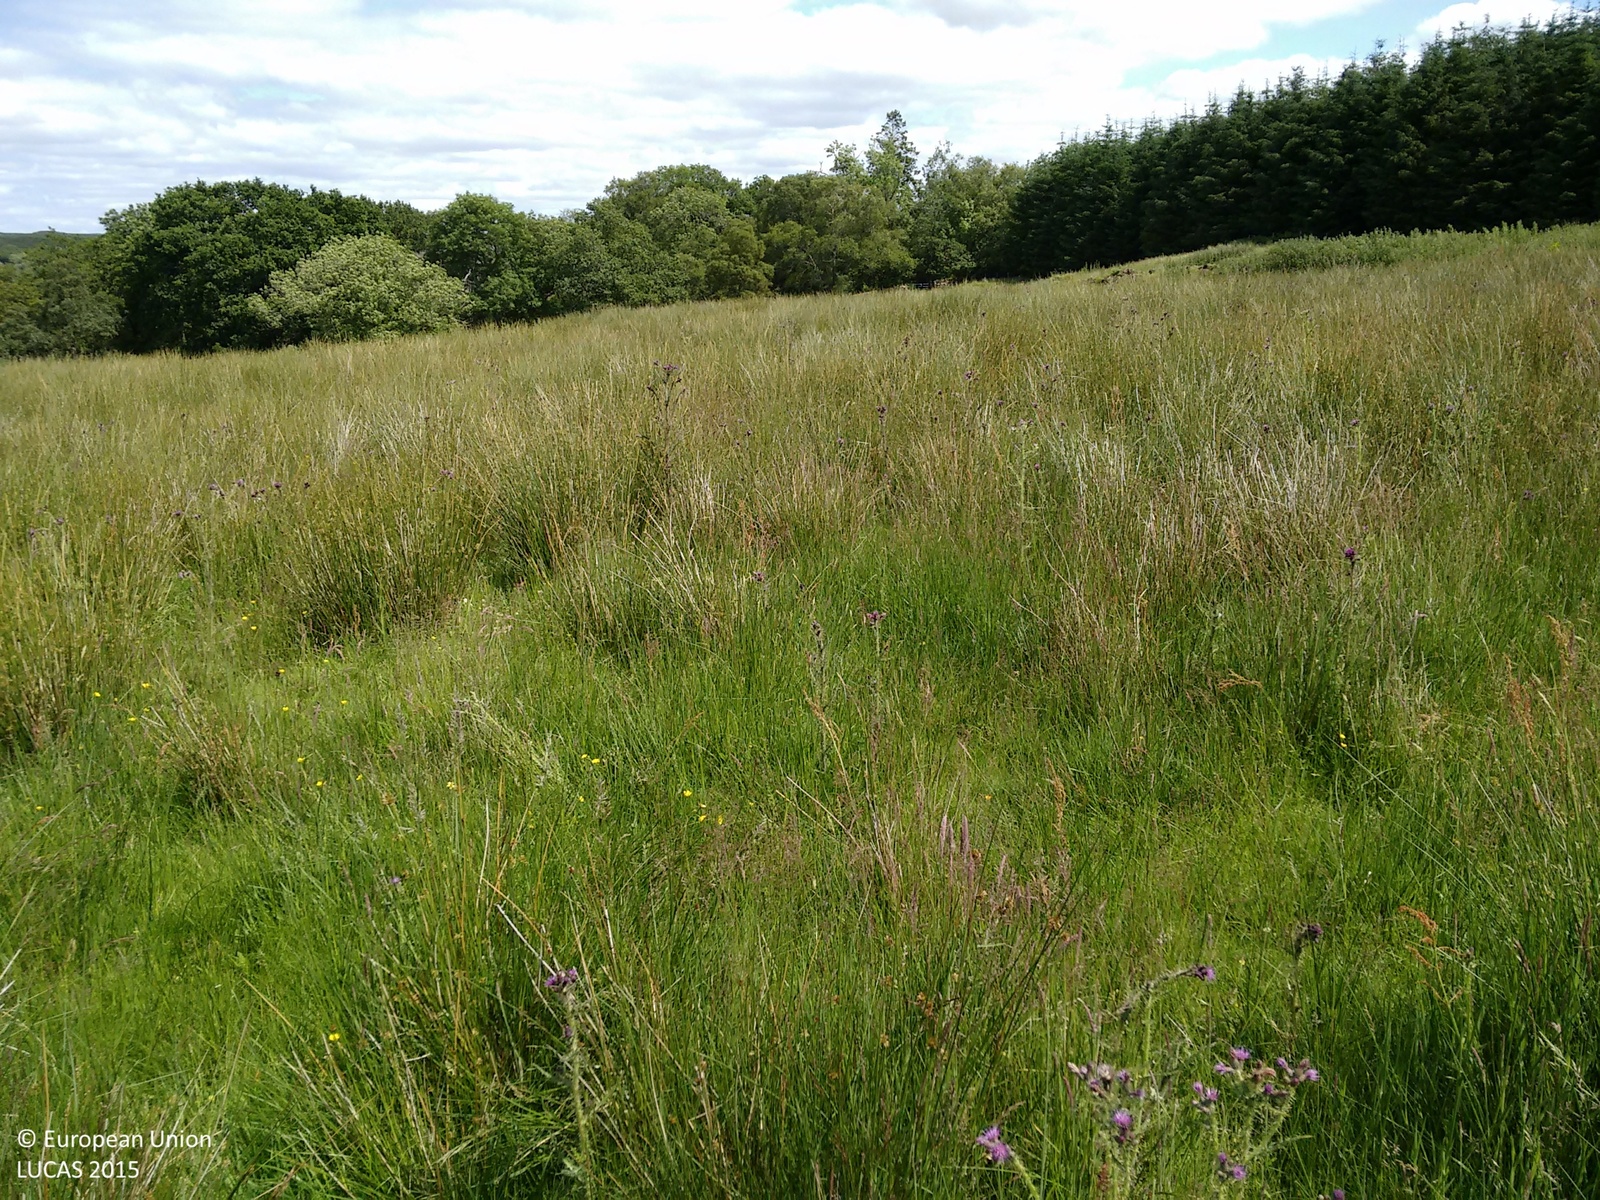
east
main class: Grassland
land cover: Grassland without tree/shrub cover
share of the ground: > 75 %
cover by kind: herbaceous plants 100 %
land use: Agriculture (excluding fallow land and kitchen gardens)
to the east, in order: Grassland without tree/shrub cover; Rivers and streams; Grassland without tree/shrub cover; Rivers and streams; Grassland without tree/shrub cover; Rivers and streams; Grassland without tree/shrub cover; Fences; Tracks; Broadleaved woodland; Rivers and streams; Broadleaved woodland; Tracks; Broadleaved woodland; Fences; Grassland without tree/shrub cover
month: July
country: GB
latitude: 55.1157
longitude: -4.2212
